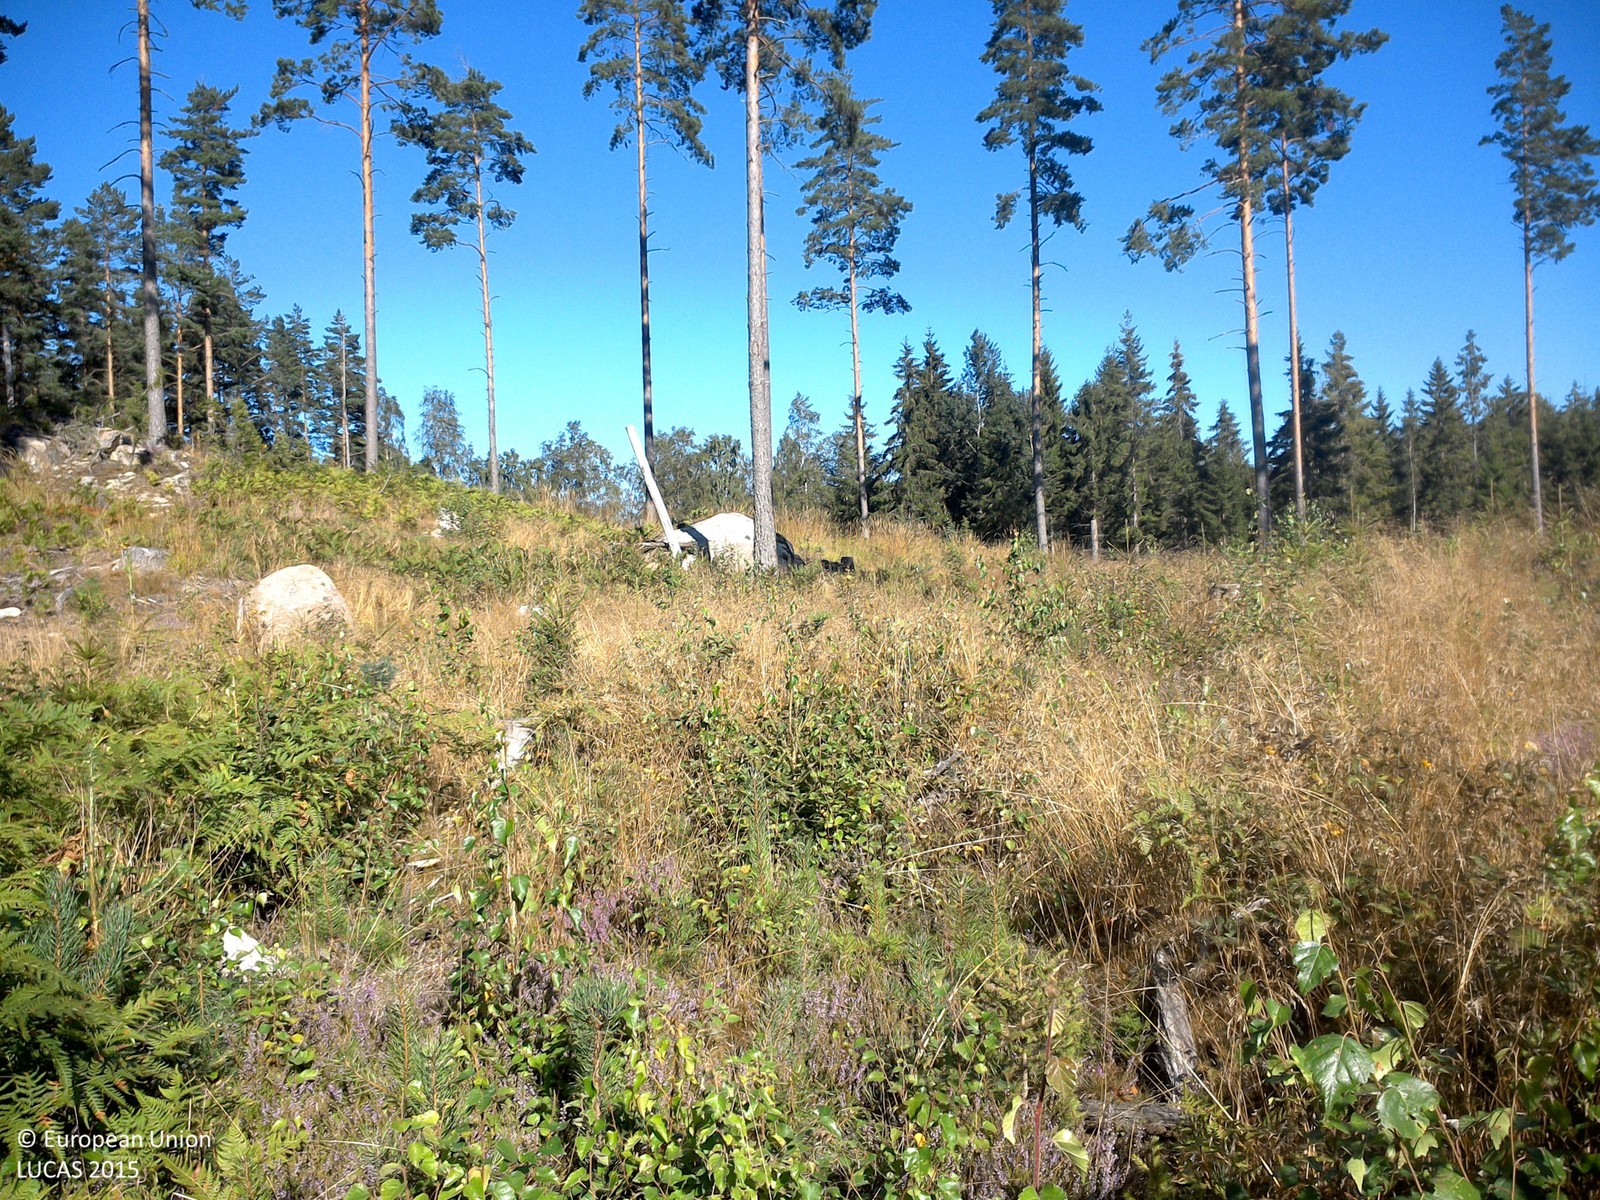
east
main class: Grassland
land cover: Grassland with sparse tree/shrub cover
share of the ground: > 75 %
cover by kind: herbaceous plants 90 %, broadleaved forest trees 5 %, unconsolidated bare surface 5 %
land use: Forestry
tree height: < 5 m
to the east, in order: Grassland with sparse tree/shrub cover; Pine dominated coniferous woodland; Spruce dominated coniferous woodland; Spruce dominated mixed woodland; Dry stone walls; Ditches and canals; Spruce dominated mixed woodland; Fences; Grassland with sparse tree/shrub cover; Fences; Spruce dominated mixed woodland
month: August
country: SE
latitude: 58.0623
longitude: 15.2661
